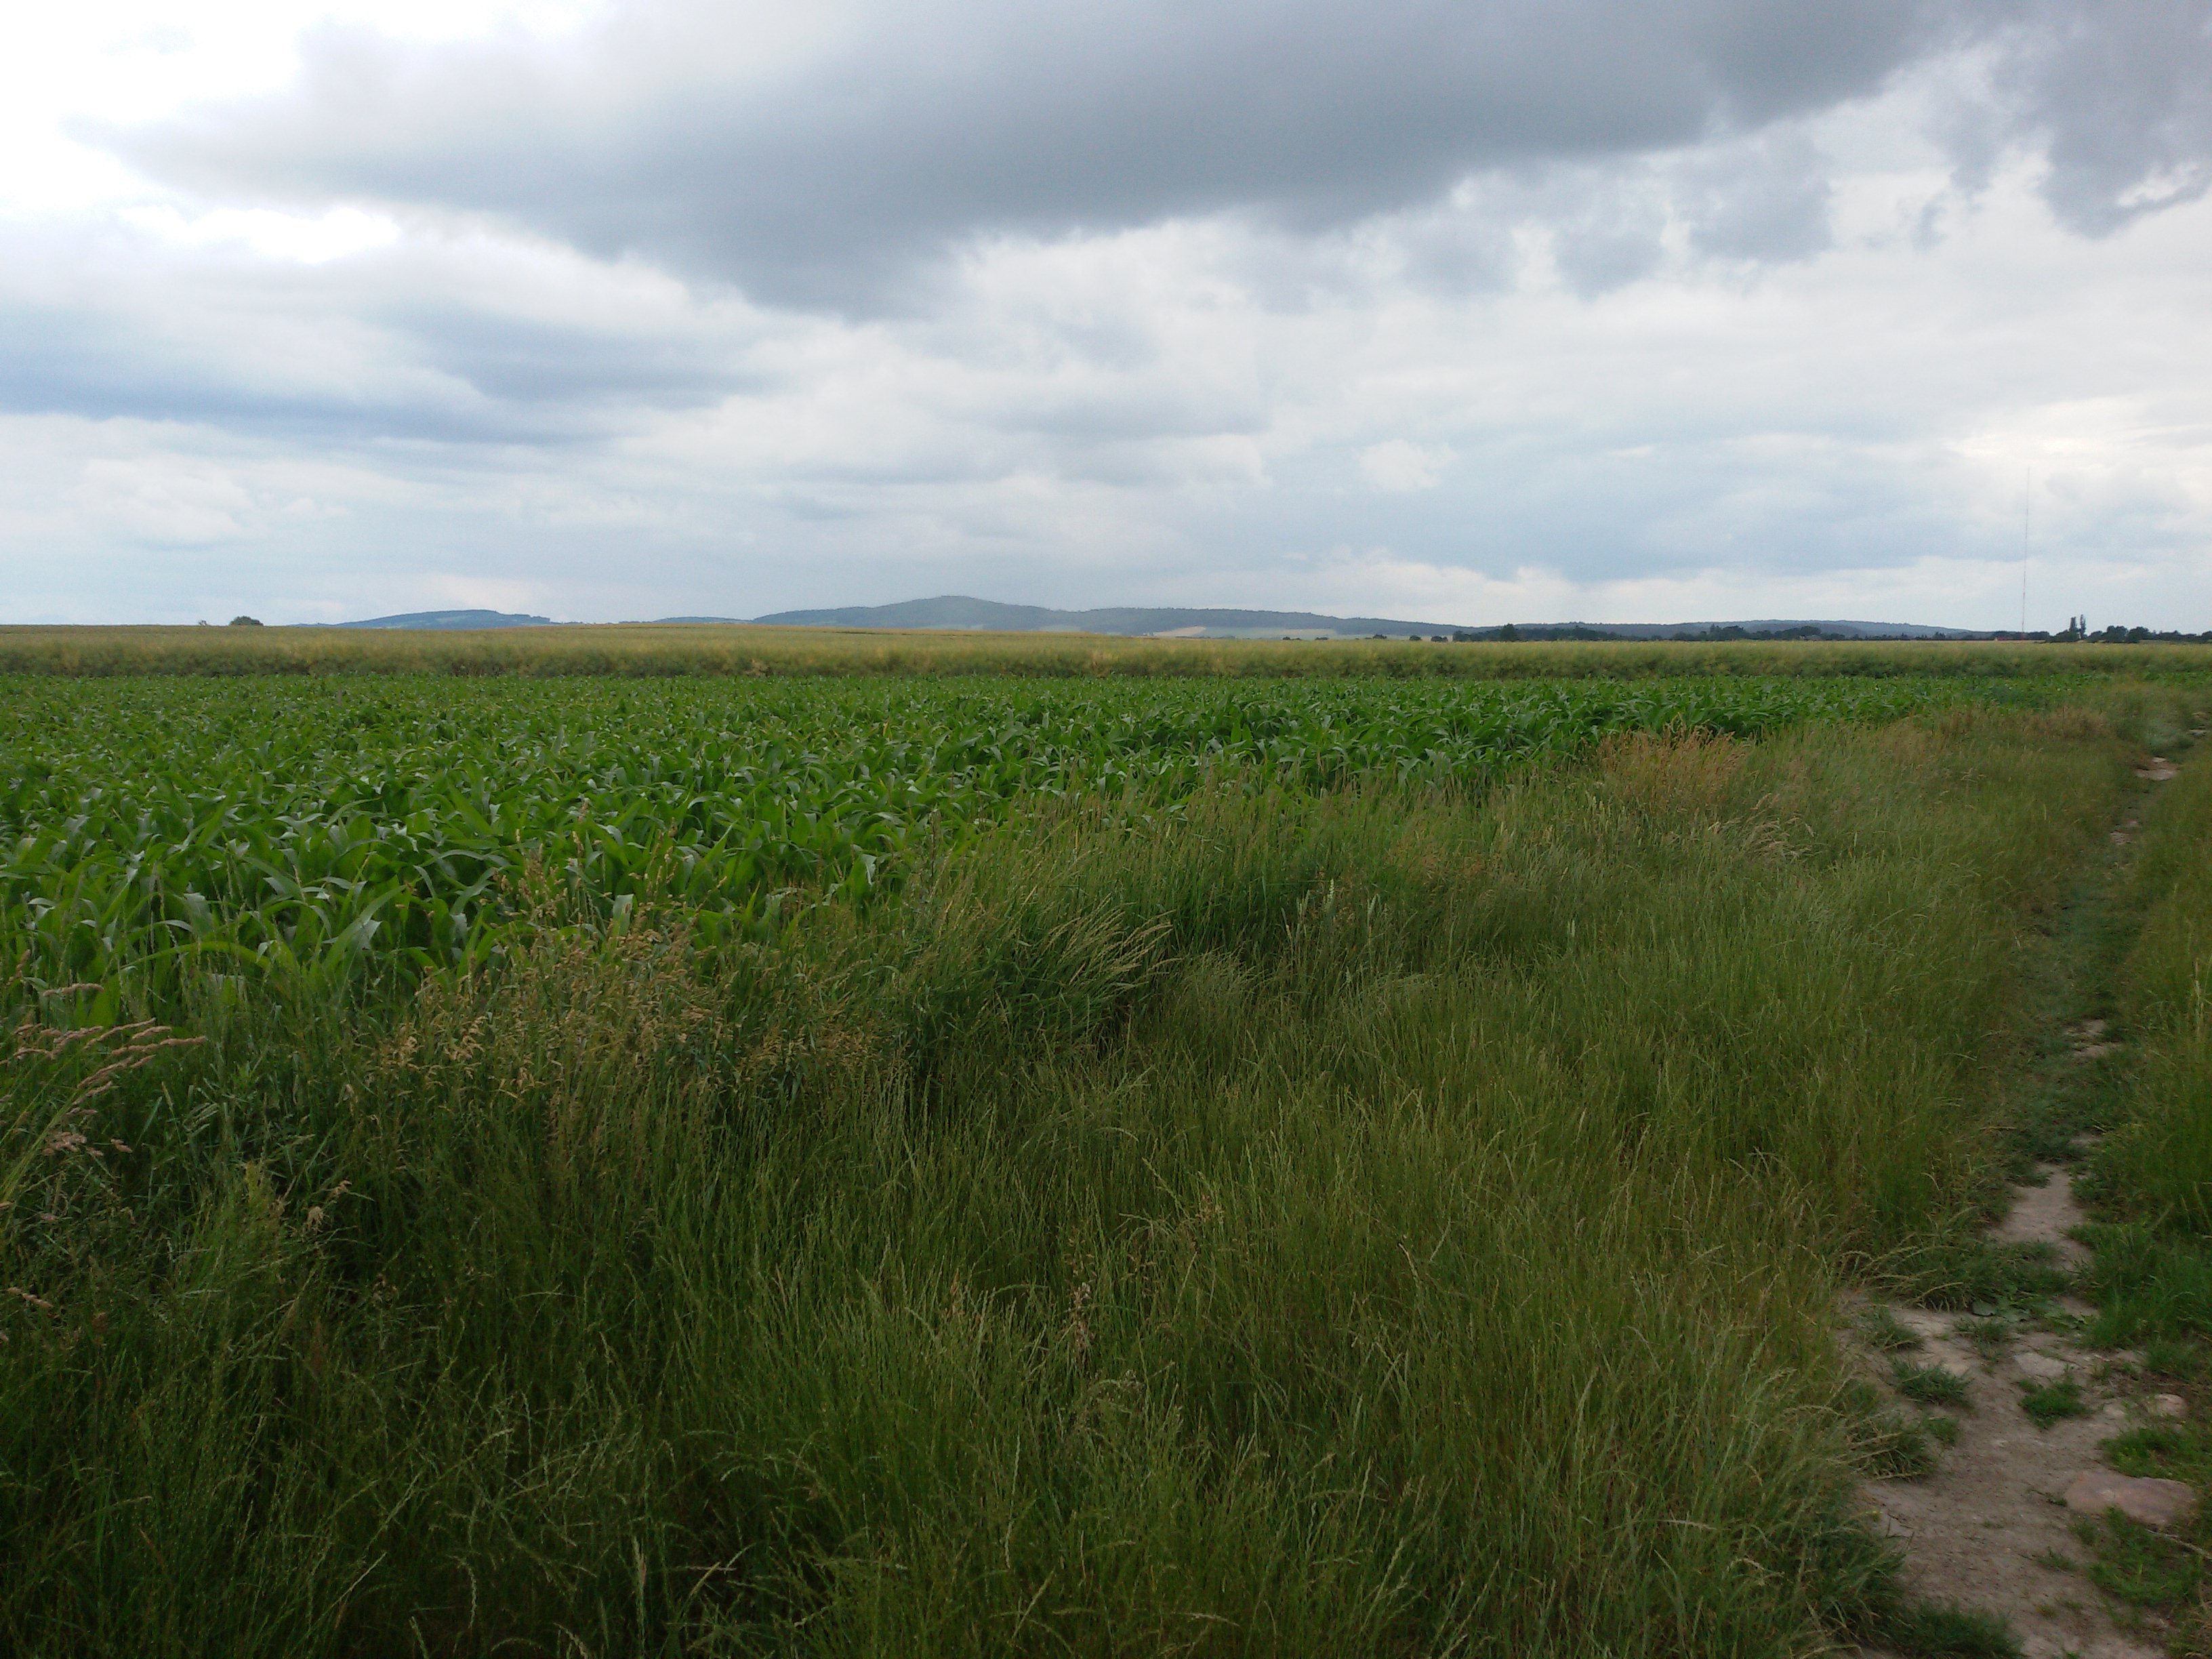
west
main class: Cropland
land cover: Rape and turnip rape
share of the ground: > 75 %
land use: Agriculture (excluding fallow land and kitchen gardens)
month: June
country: PL
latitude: 50.6956
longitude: 17.2171
